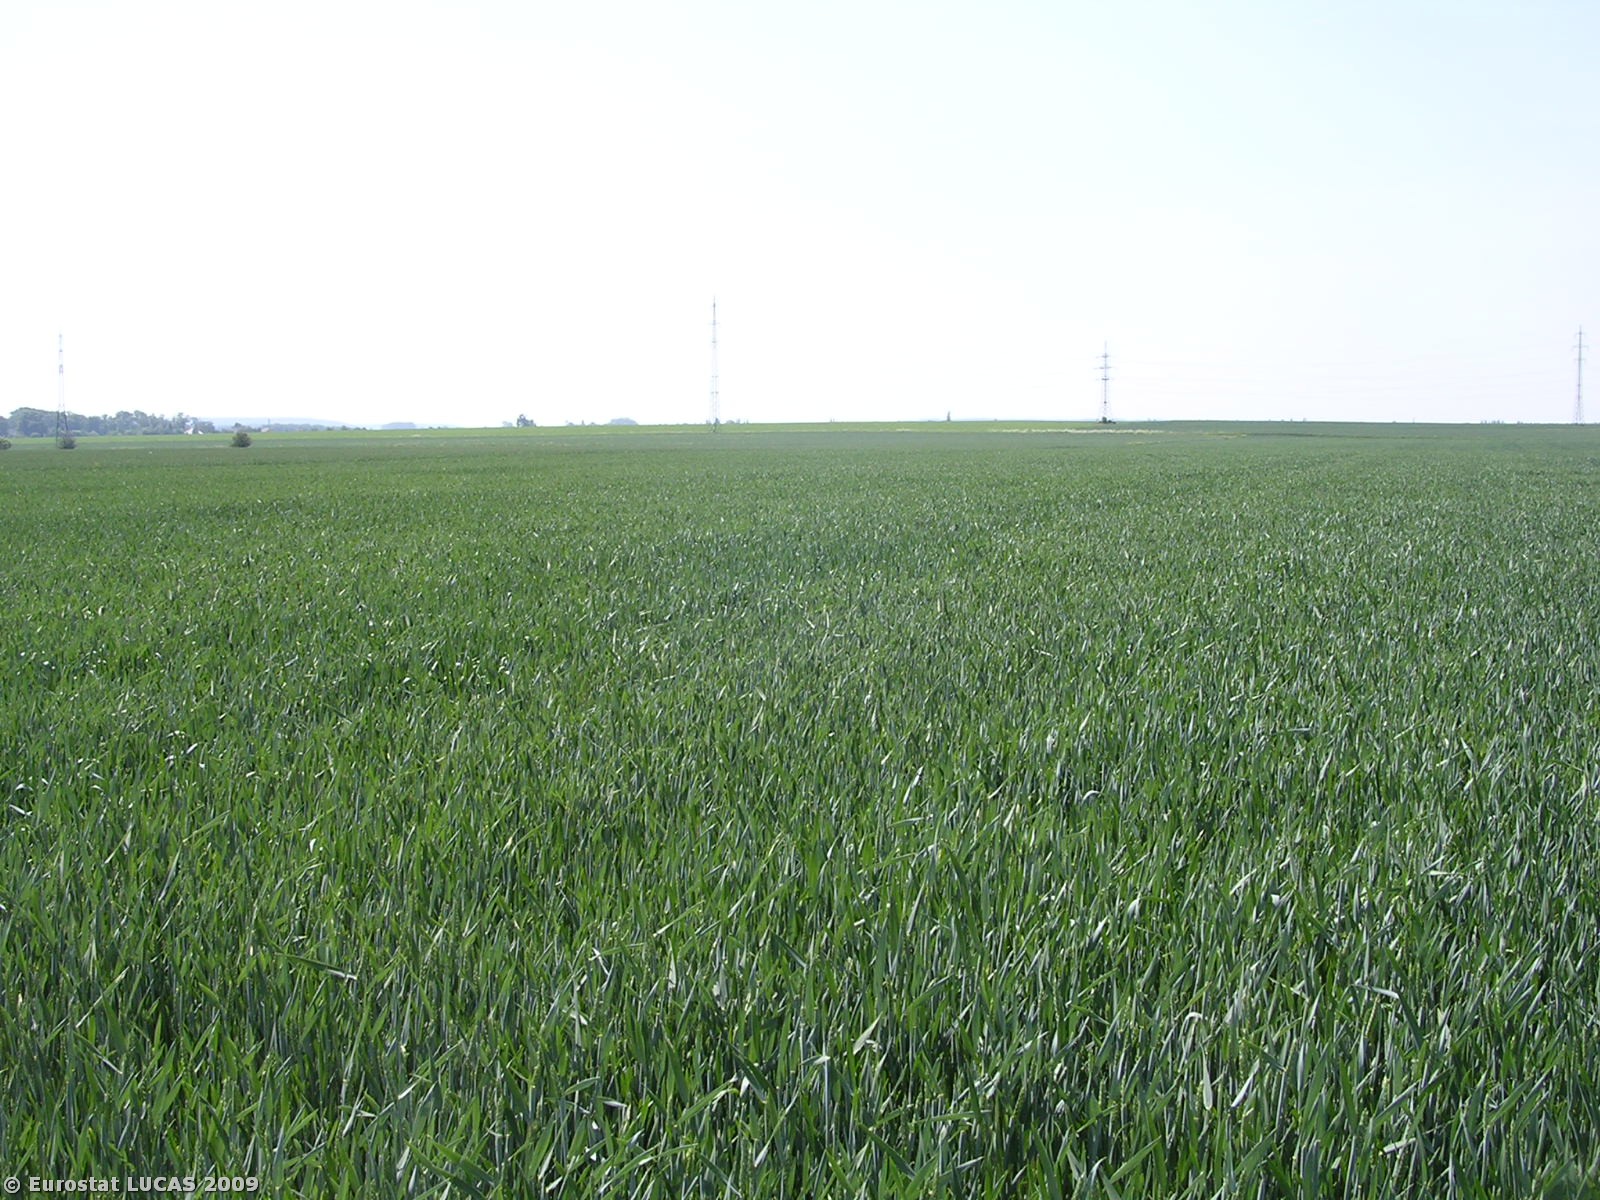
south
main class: Cropland
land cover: Common wheat
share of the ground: > 75 %
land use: Agriculture (excluding fallow land and kitchen gardens)
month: May
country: CZ
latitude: 50.3477
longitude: 14.9353
